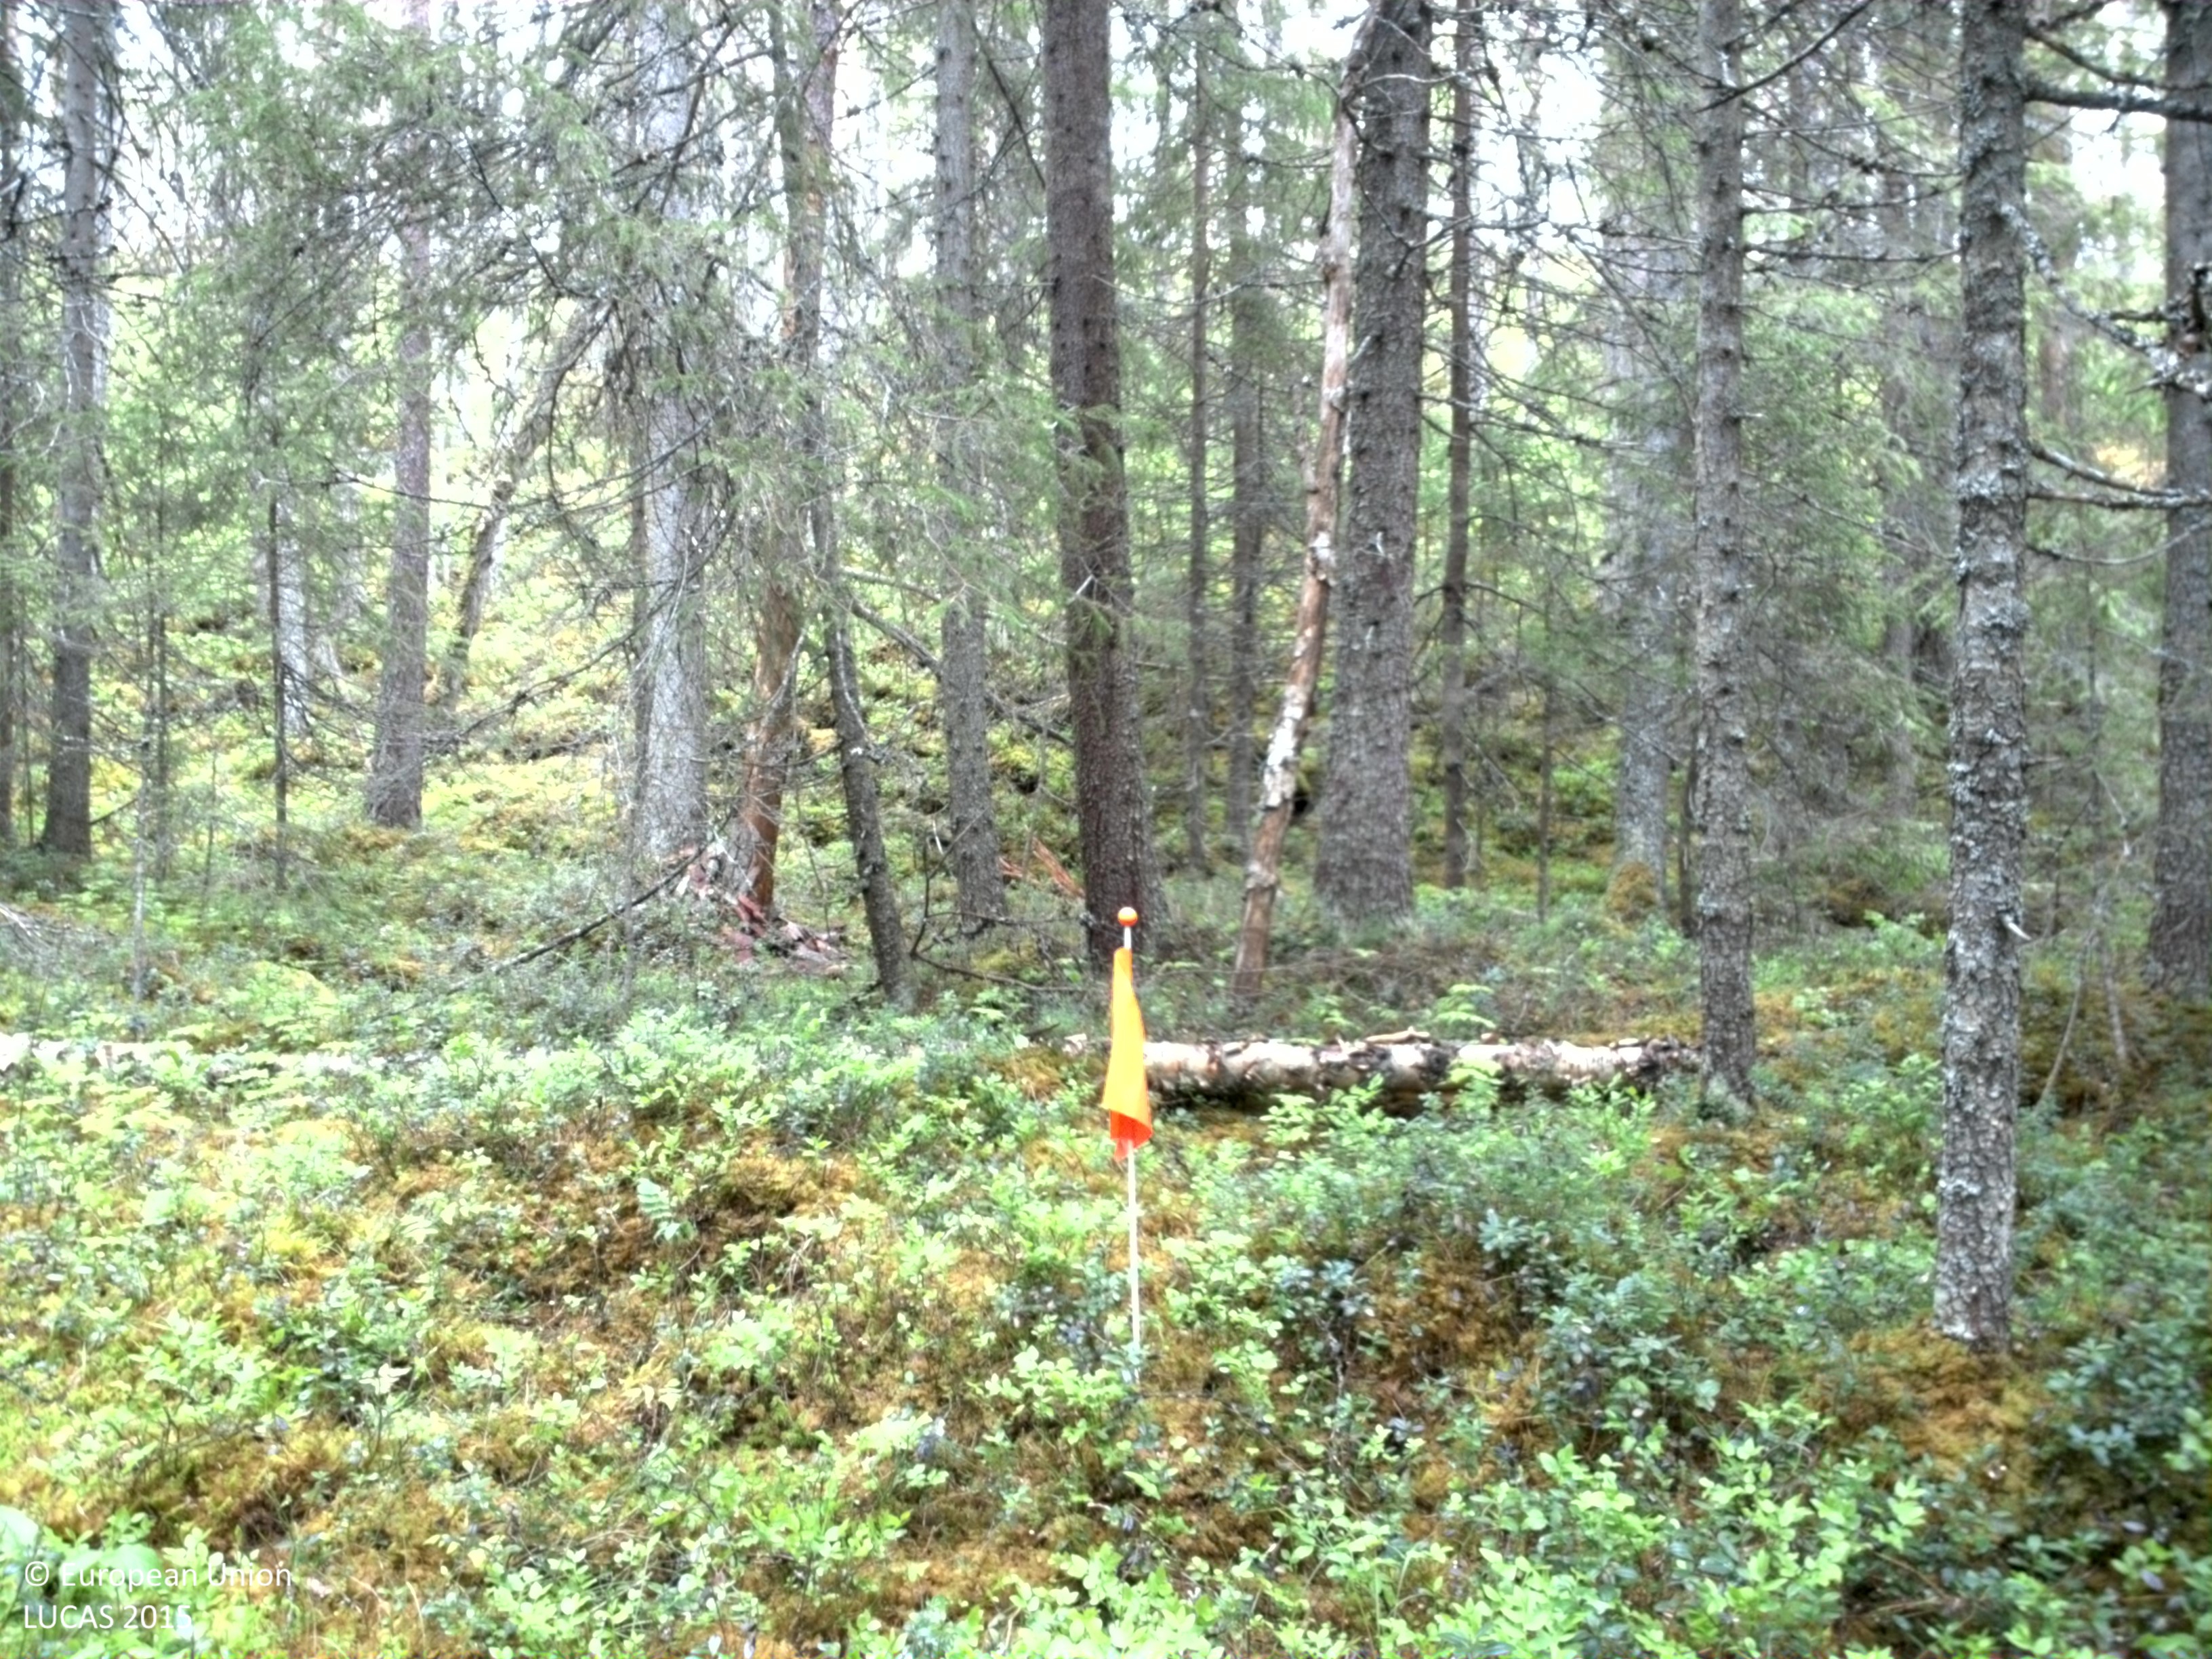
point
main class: Woodland
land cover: Spruce dominated coniferous woodland
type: boreal forest
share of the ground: > 75 %
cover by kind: coniferous forest trees 80 %, shrubs 10 %, lichens and mosses 10 %
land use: Forestry
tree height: > 5 m
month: June
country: SE
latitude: 62.2259
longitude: 13.6206
